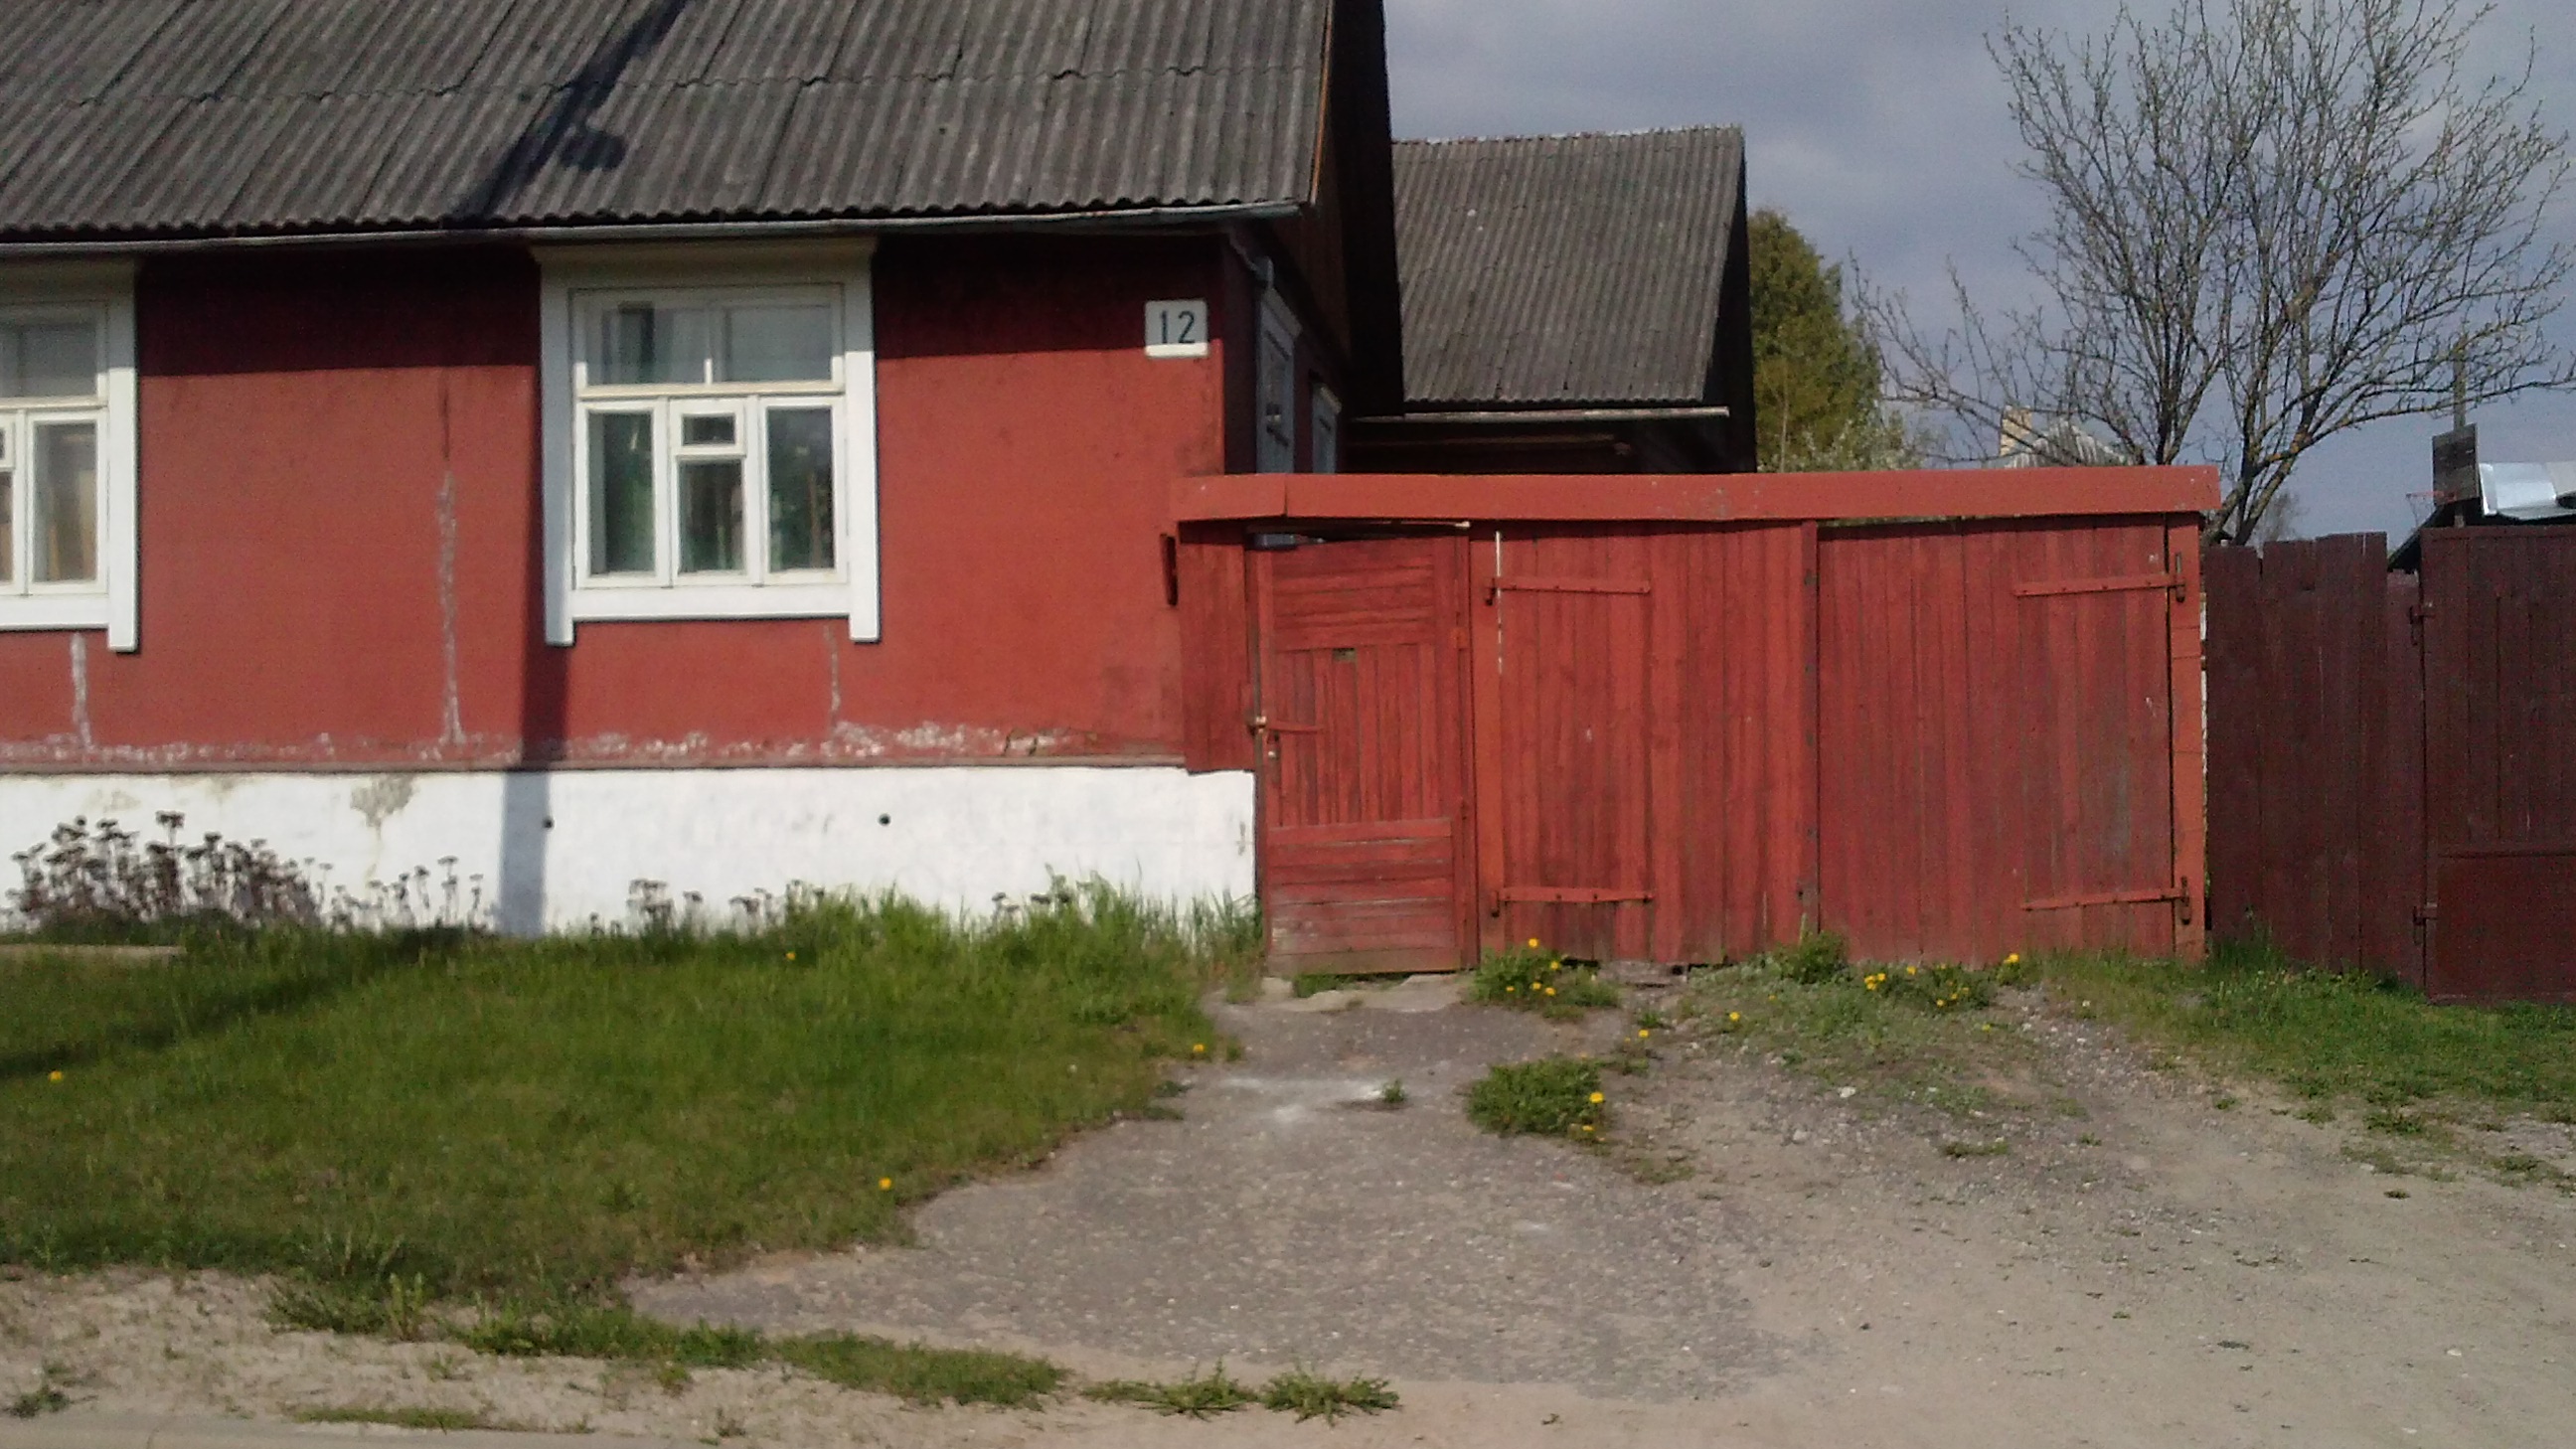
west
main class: Cropland
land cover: Apple fruit
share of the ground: > 75 %
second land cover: Grassland without tree/shrub cover
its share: > 75 %
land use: Kitchen garden
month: May
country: LV
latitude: 55.9015
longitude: 27.1730
